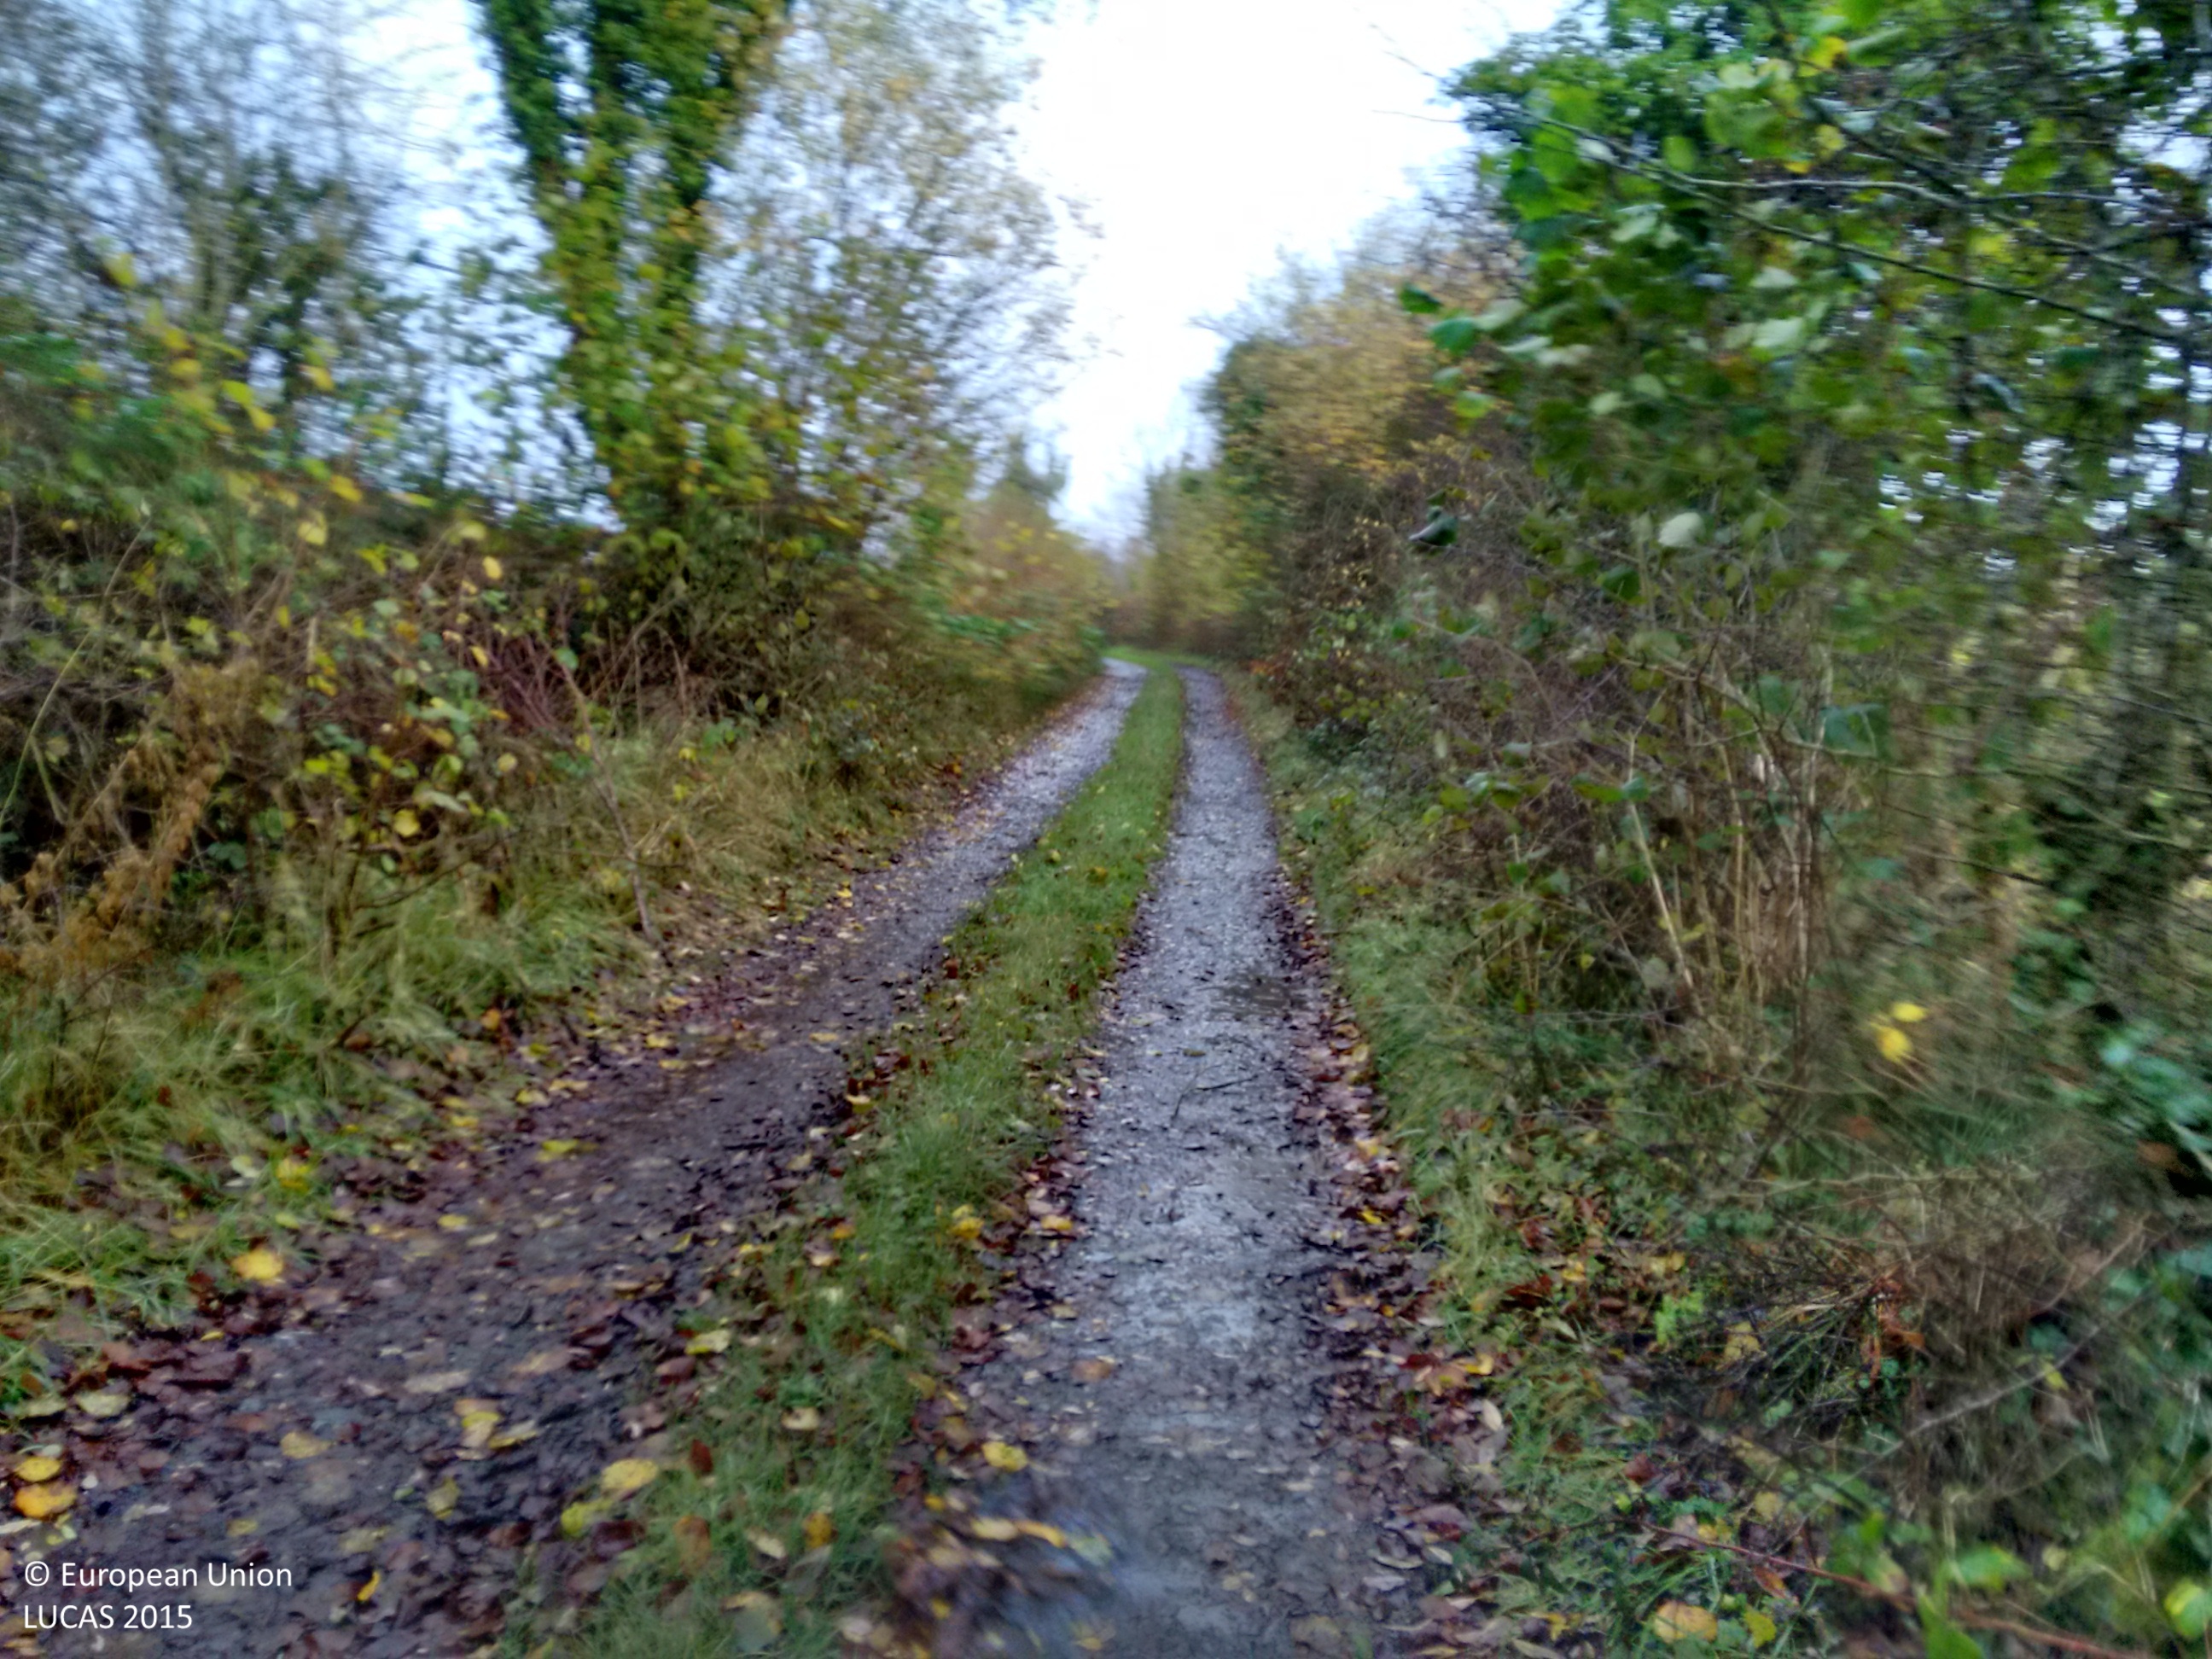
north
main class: Grassland
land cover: Grassland without tree/shrub cover
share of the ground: > 75 %
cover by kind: herbaceous plants 100 %
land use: Agriculture (excluding fallow land and kitchen gardens)
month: November
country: IE
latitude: 53.9446
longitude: -7.9524
